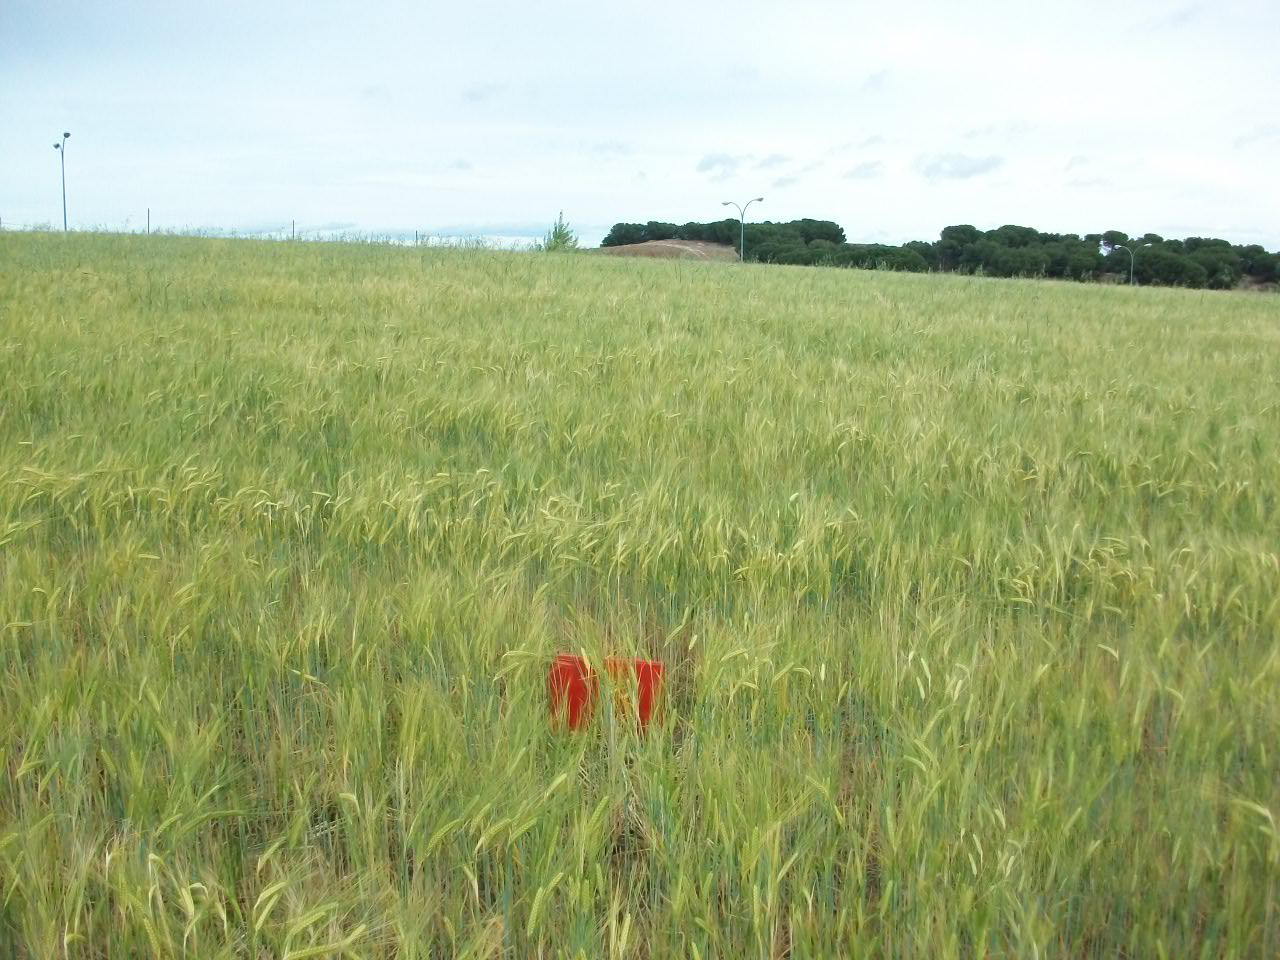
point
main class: Cropland
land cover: Barley
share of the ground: > 75 %
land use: Agriculture (excluding fallow land and kitchen gardens)
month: April
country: ES
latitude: 40.2975
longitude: -3.9091
